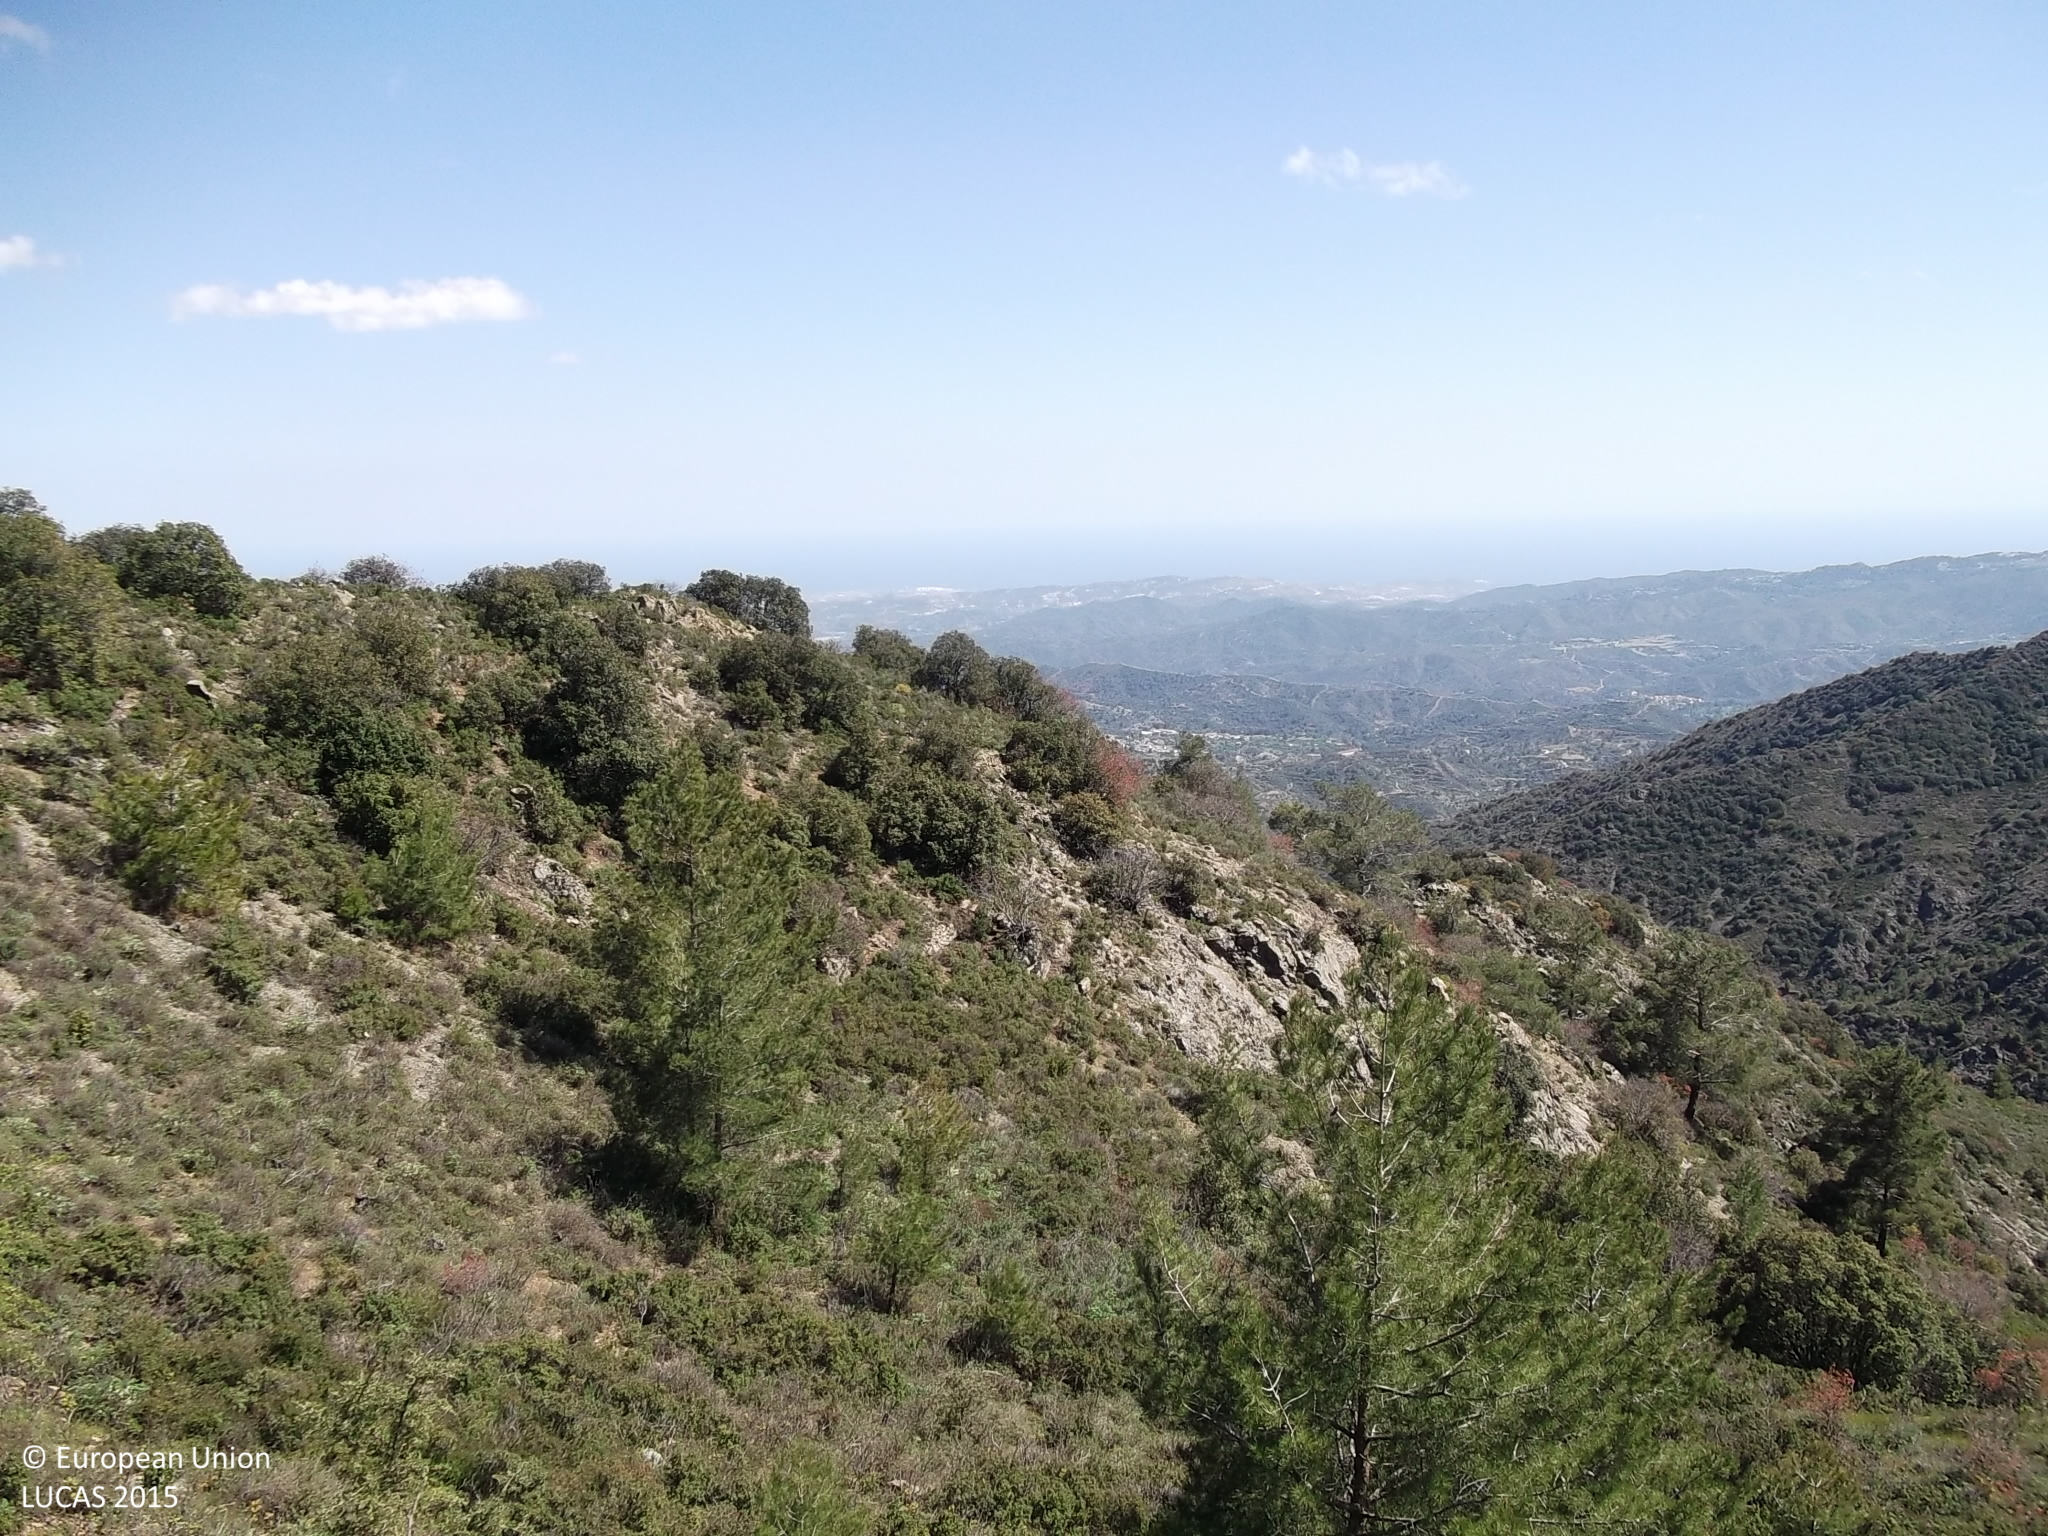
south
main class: Woodland
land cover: Pine dominated coniferous woodland
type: coniferous forest of the mediterranean region
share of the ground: 10 - 25 %
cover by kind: shrubs 65 %, coniferous forest trees 20 %, consolidated bare surface 10 %, unconsolidated bare surface 5 %
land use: Forestry
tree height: > 5 m
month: April
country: CY
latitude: 34.9005
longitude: 33.1695
